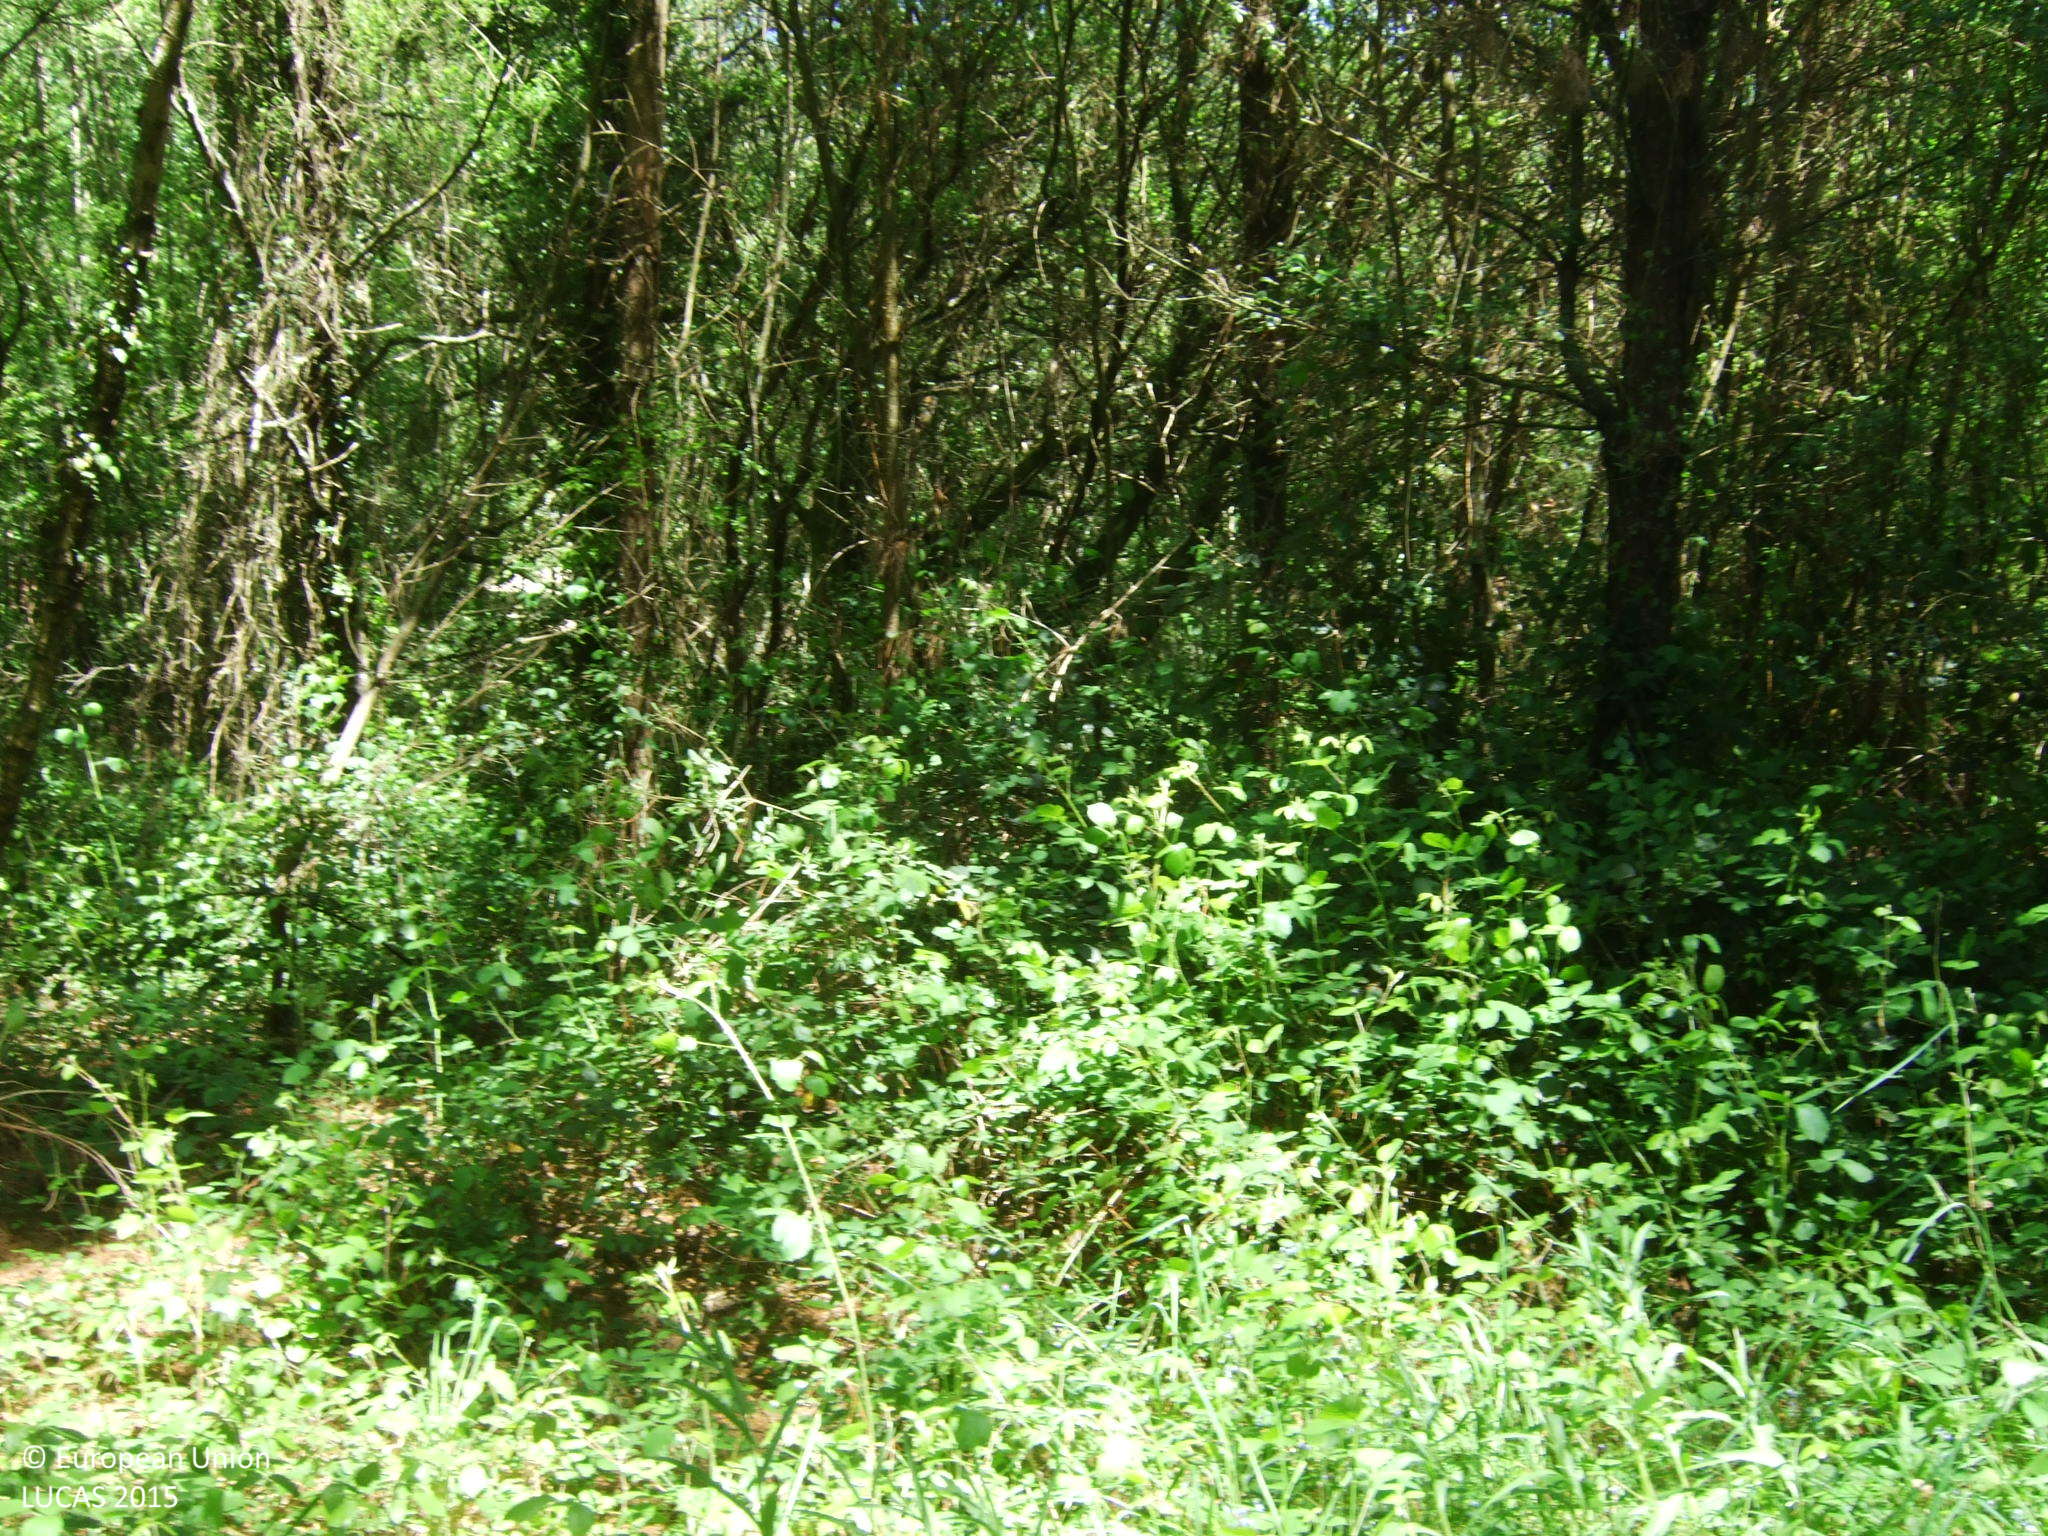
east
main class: Woodland
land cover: Pine dominated mixed woodland
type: exotic forest
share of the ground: 50 - 75 %
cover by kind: coniferous forest trees 40 %, broadleaved forest trees 30 %, shrubs 30 %
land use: Forestry
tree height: > 5 m
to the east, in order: Pine dominated mixed woodland; Rivers and streams; Broadleaved woodland; Tracks; Broadleaved woodland; Grassland without tree/shrub cover; Groves; Fences; Grassland without tree/shrub cover; Broadleaved woodland; Grassland without tree/shrub cover
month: May
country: ES
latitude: 43.2629
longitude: -7.6631
